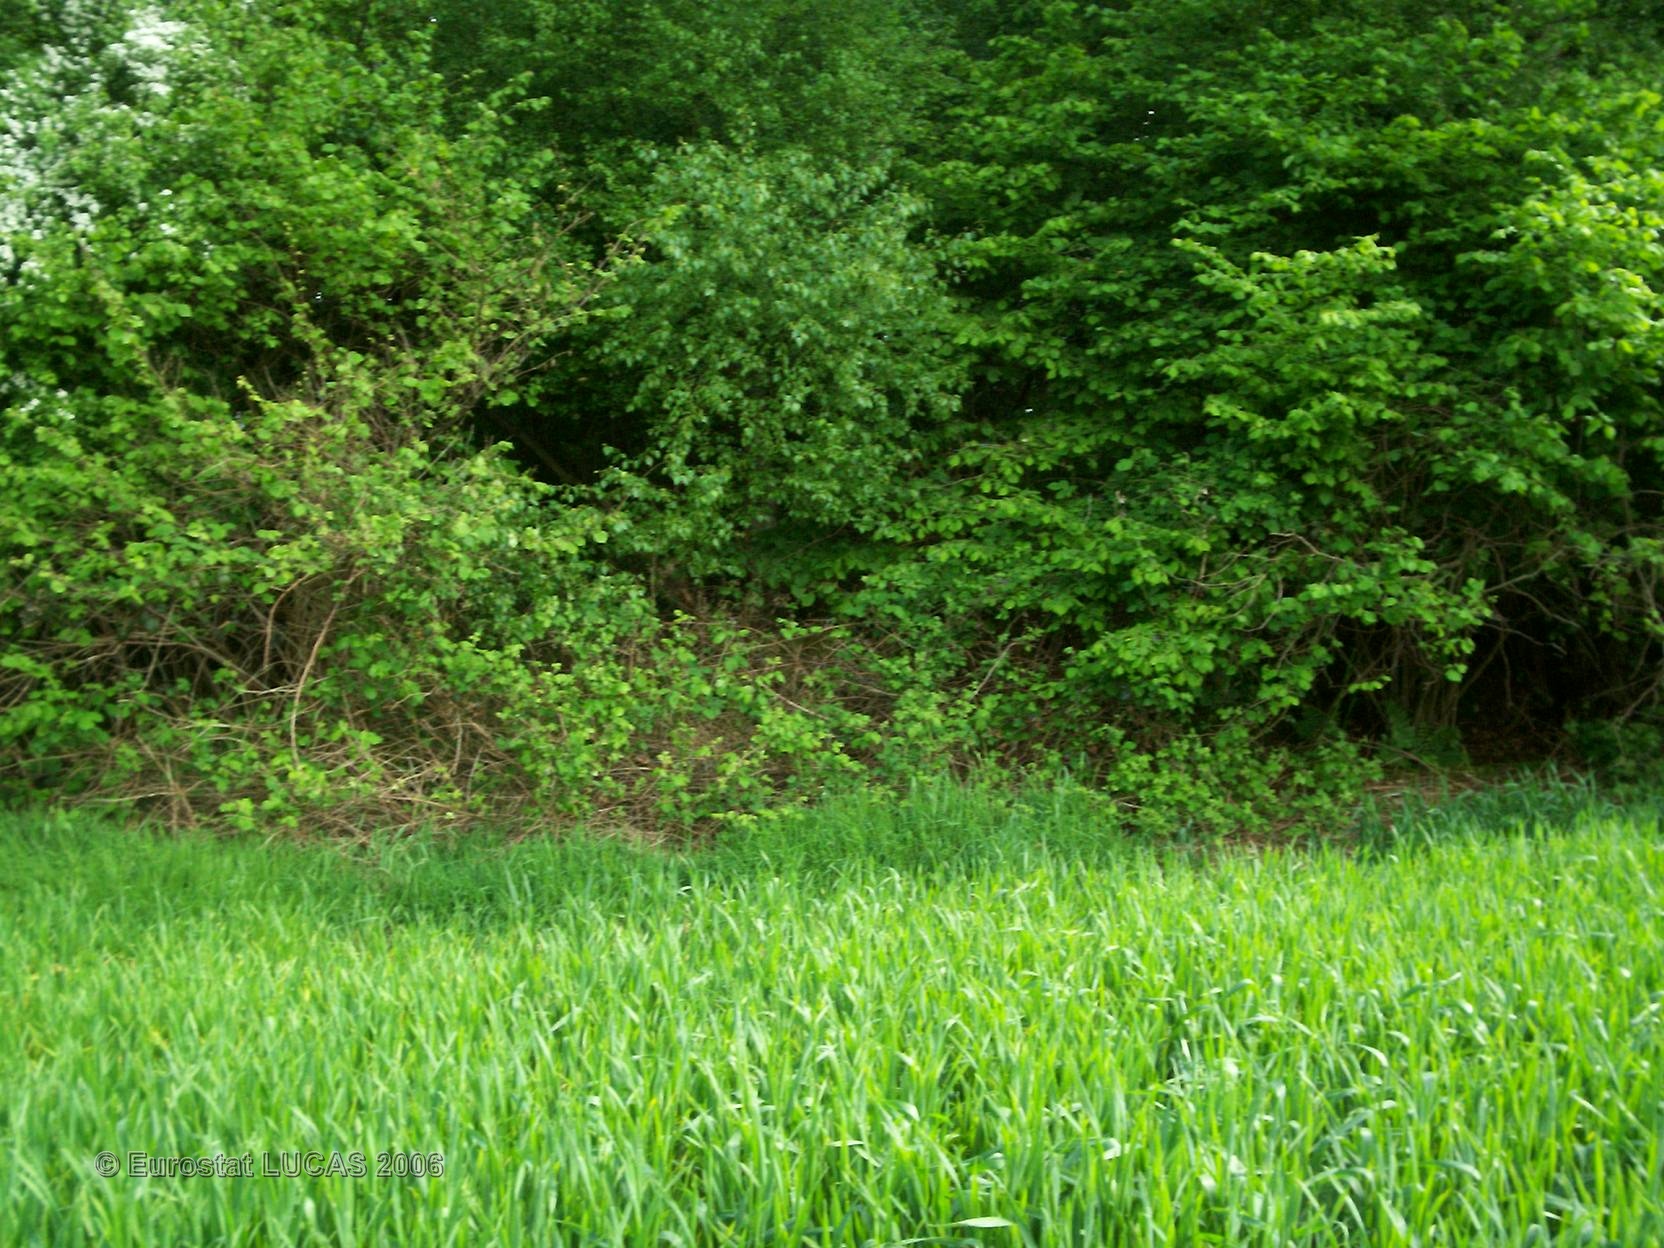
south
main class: Cropland
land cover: Common wheat
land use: Agriculture (excluding fallow land and kitchen gardens)
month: May
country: FR
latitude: 49.3891
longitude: 0.5089
